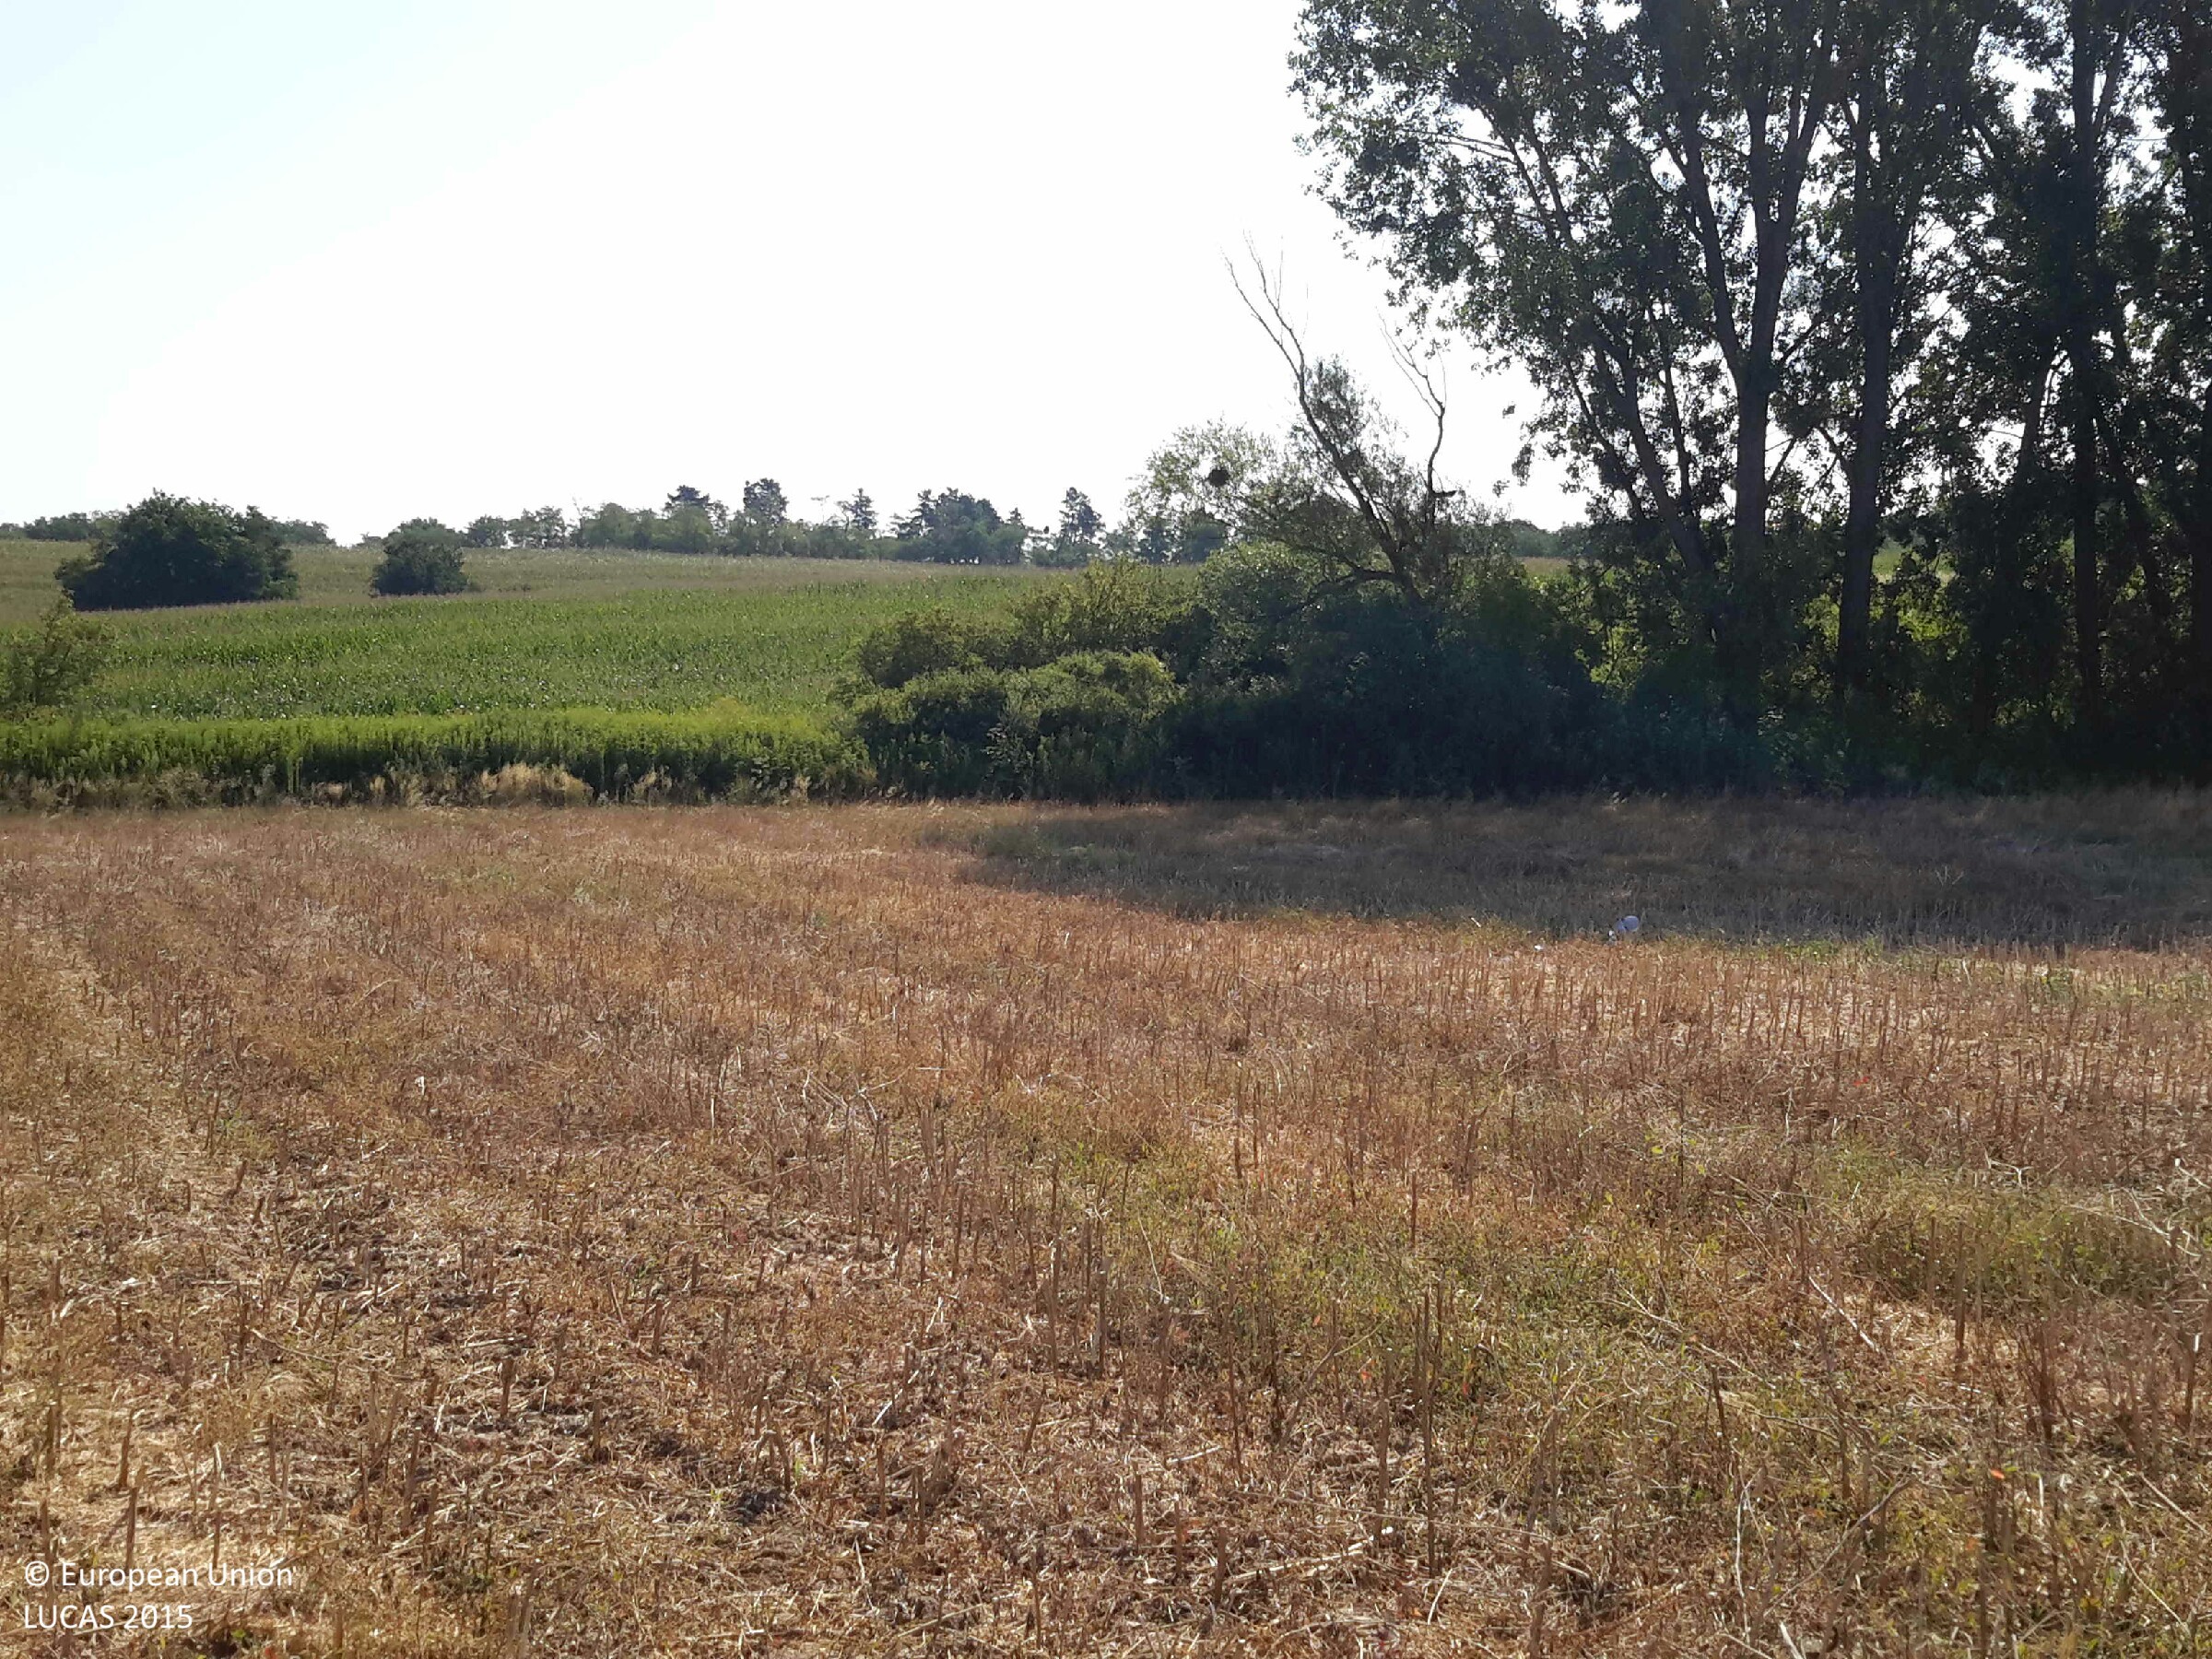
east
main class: Cropland
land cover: Rape and turnip rape
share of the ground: < 10 %
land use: Agriculture (excluding fallow land and kitchen gardens)
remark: Harvested field
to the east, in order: Rape and turnip rape; Shrubland with sparse tree cover; Ditches and canals; Shrubland with sparse tree cover; Maize; Grass margins; Maize
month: July
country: HU
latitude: 47.4891
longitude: 17.8806
